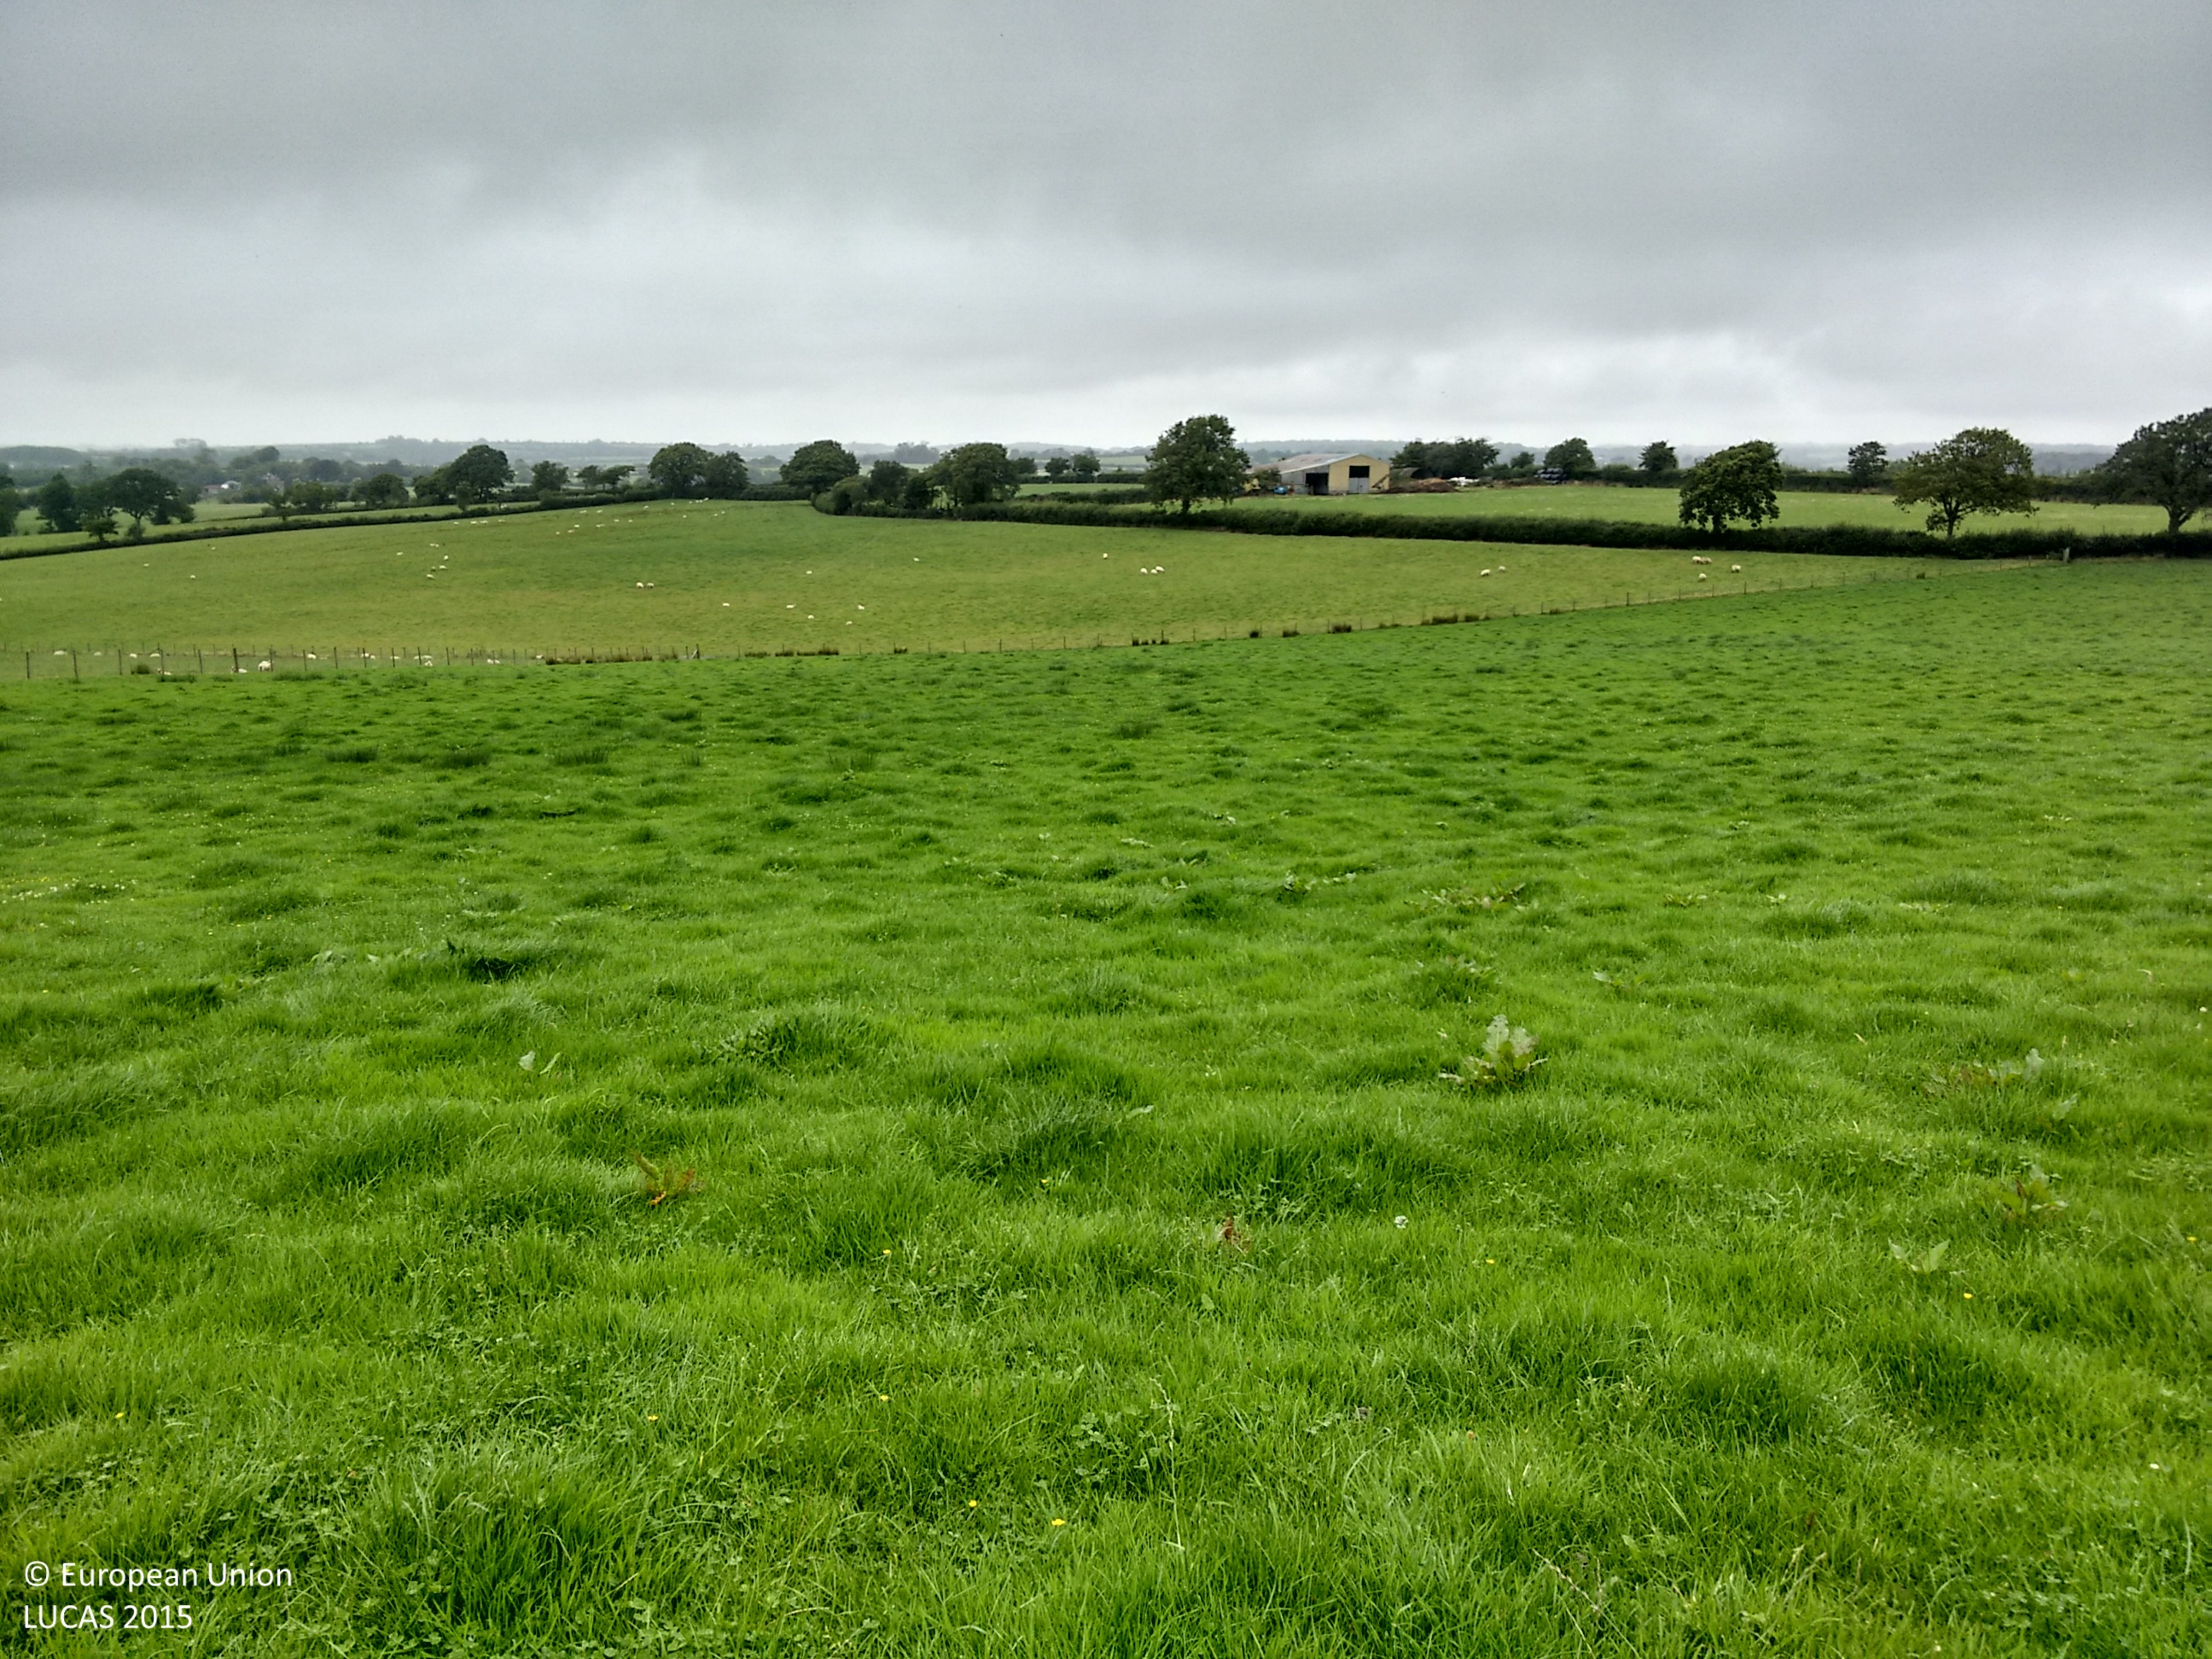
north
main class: Grassland
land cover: Grassland without tree/shrub cover
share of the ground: > 75 %
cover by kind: herbaceous plants 100 %
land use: Agriculture (excluding fallow land and kitchen gardens)
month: August
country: GB
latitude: 50.9278
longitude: -3.6459
